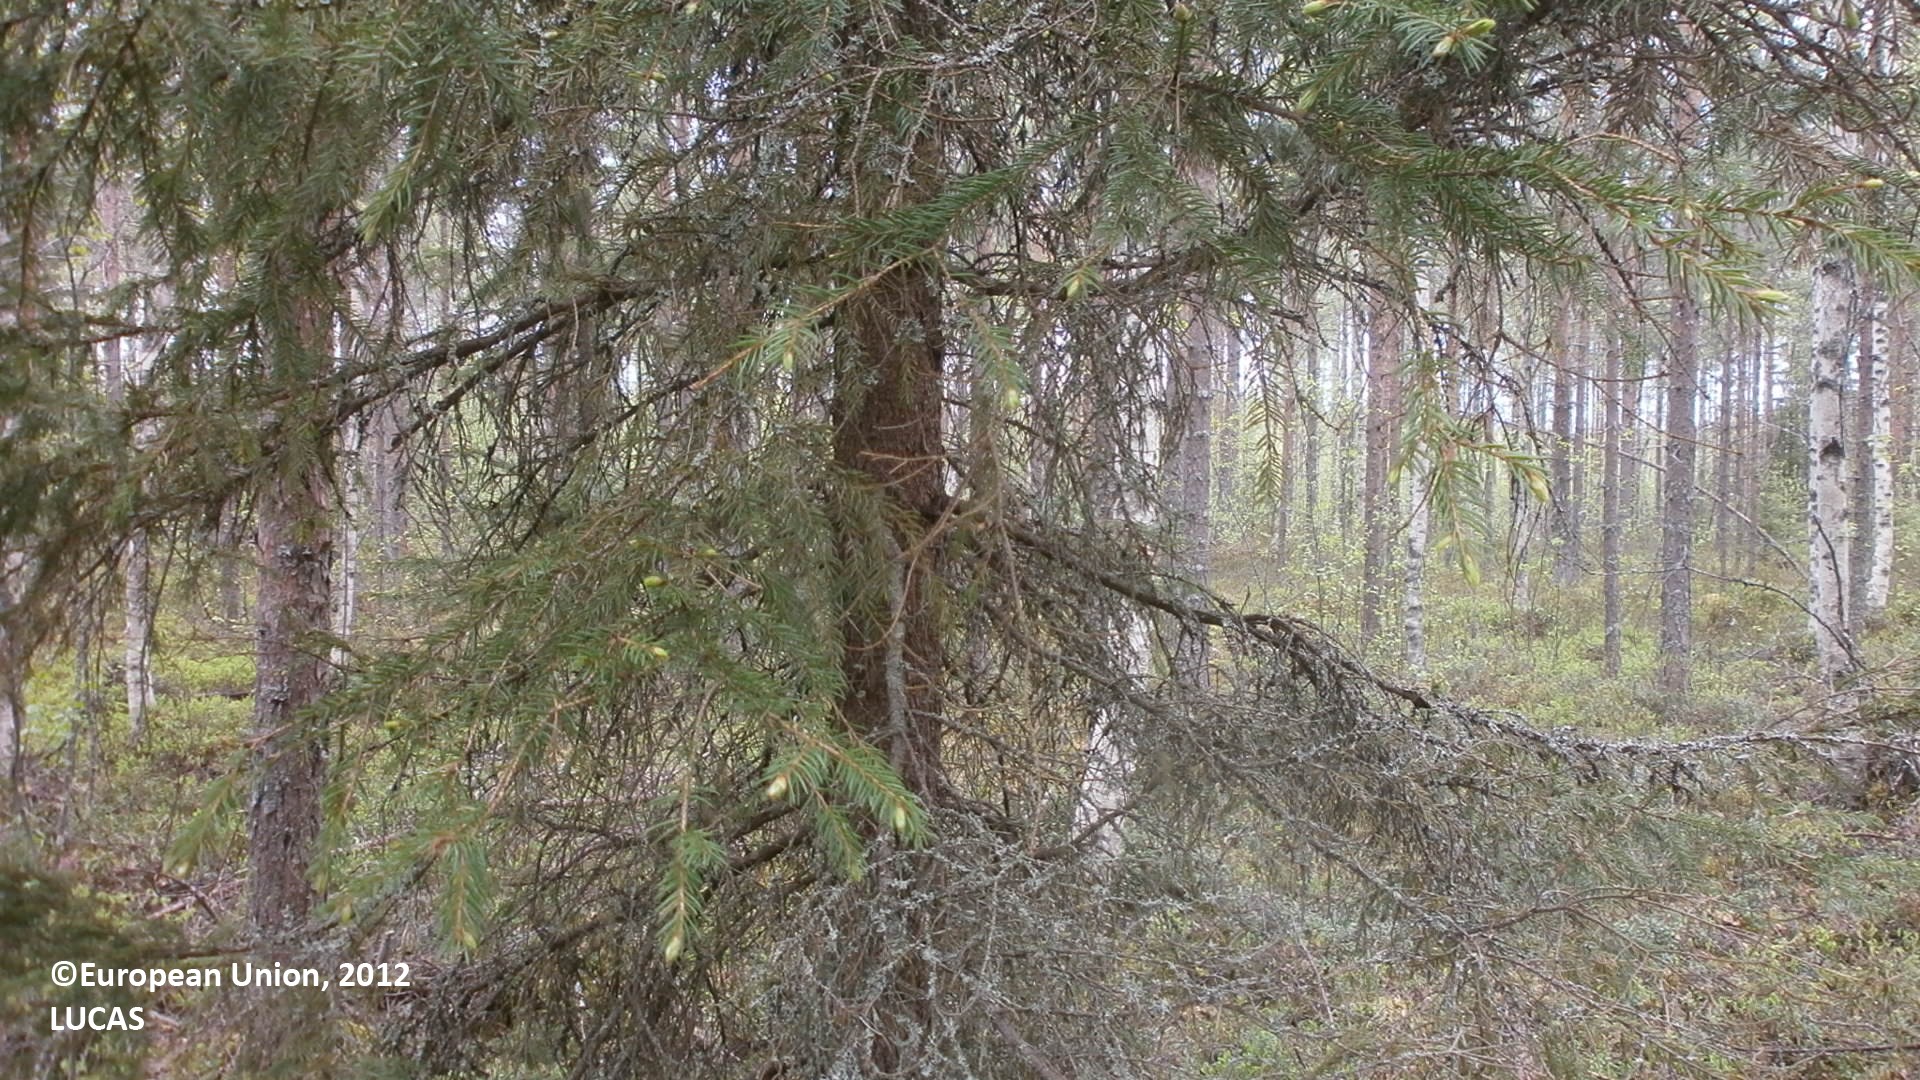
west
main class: Woodland
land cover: Pine dominated mixed woodland
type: hemiboreal forest and nemoral coniferous forest and mixed broadleaved-coniferous forest
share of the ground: 50 - 75 %
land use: Forestry
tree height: > 5 m
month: June
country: FI
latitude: 64.2953
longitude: 25.8678
